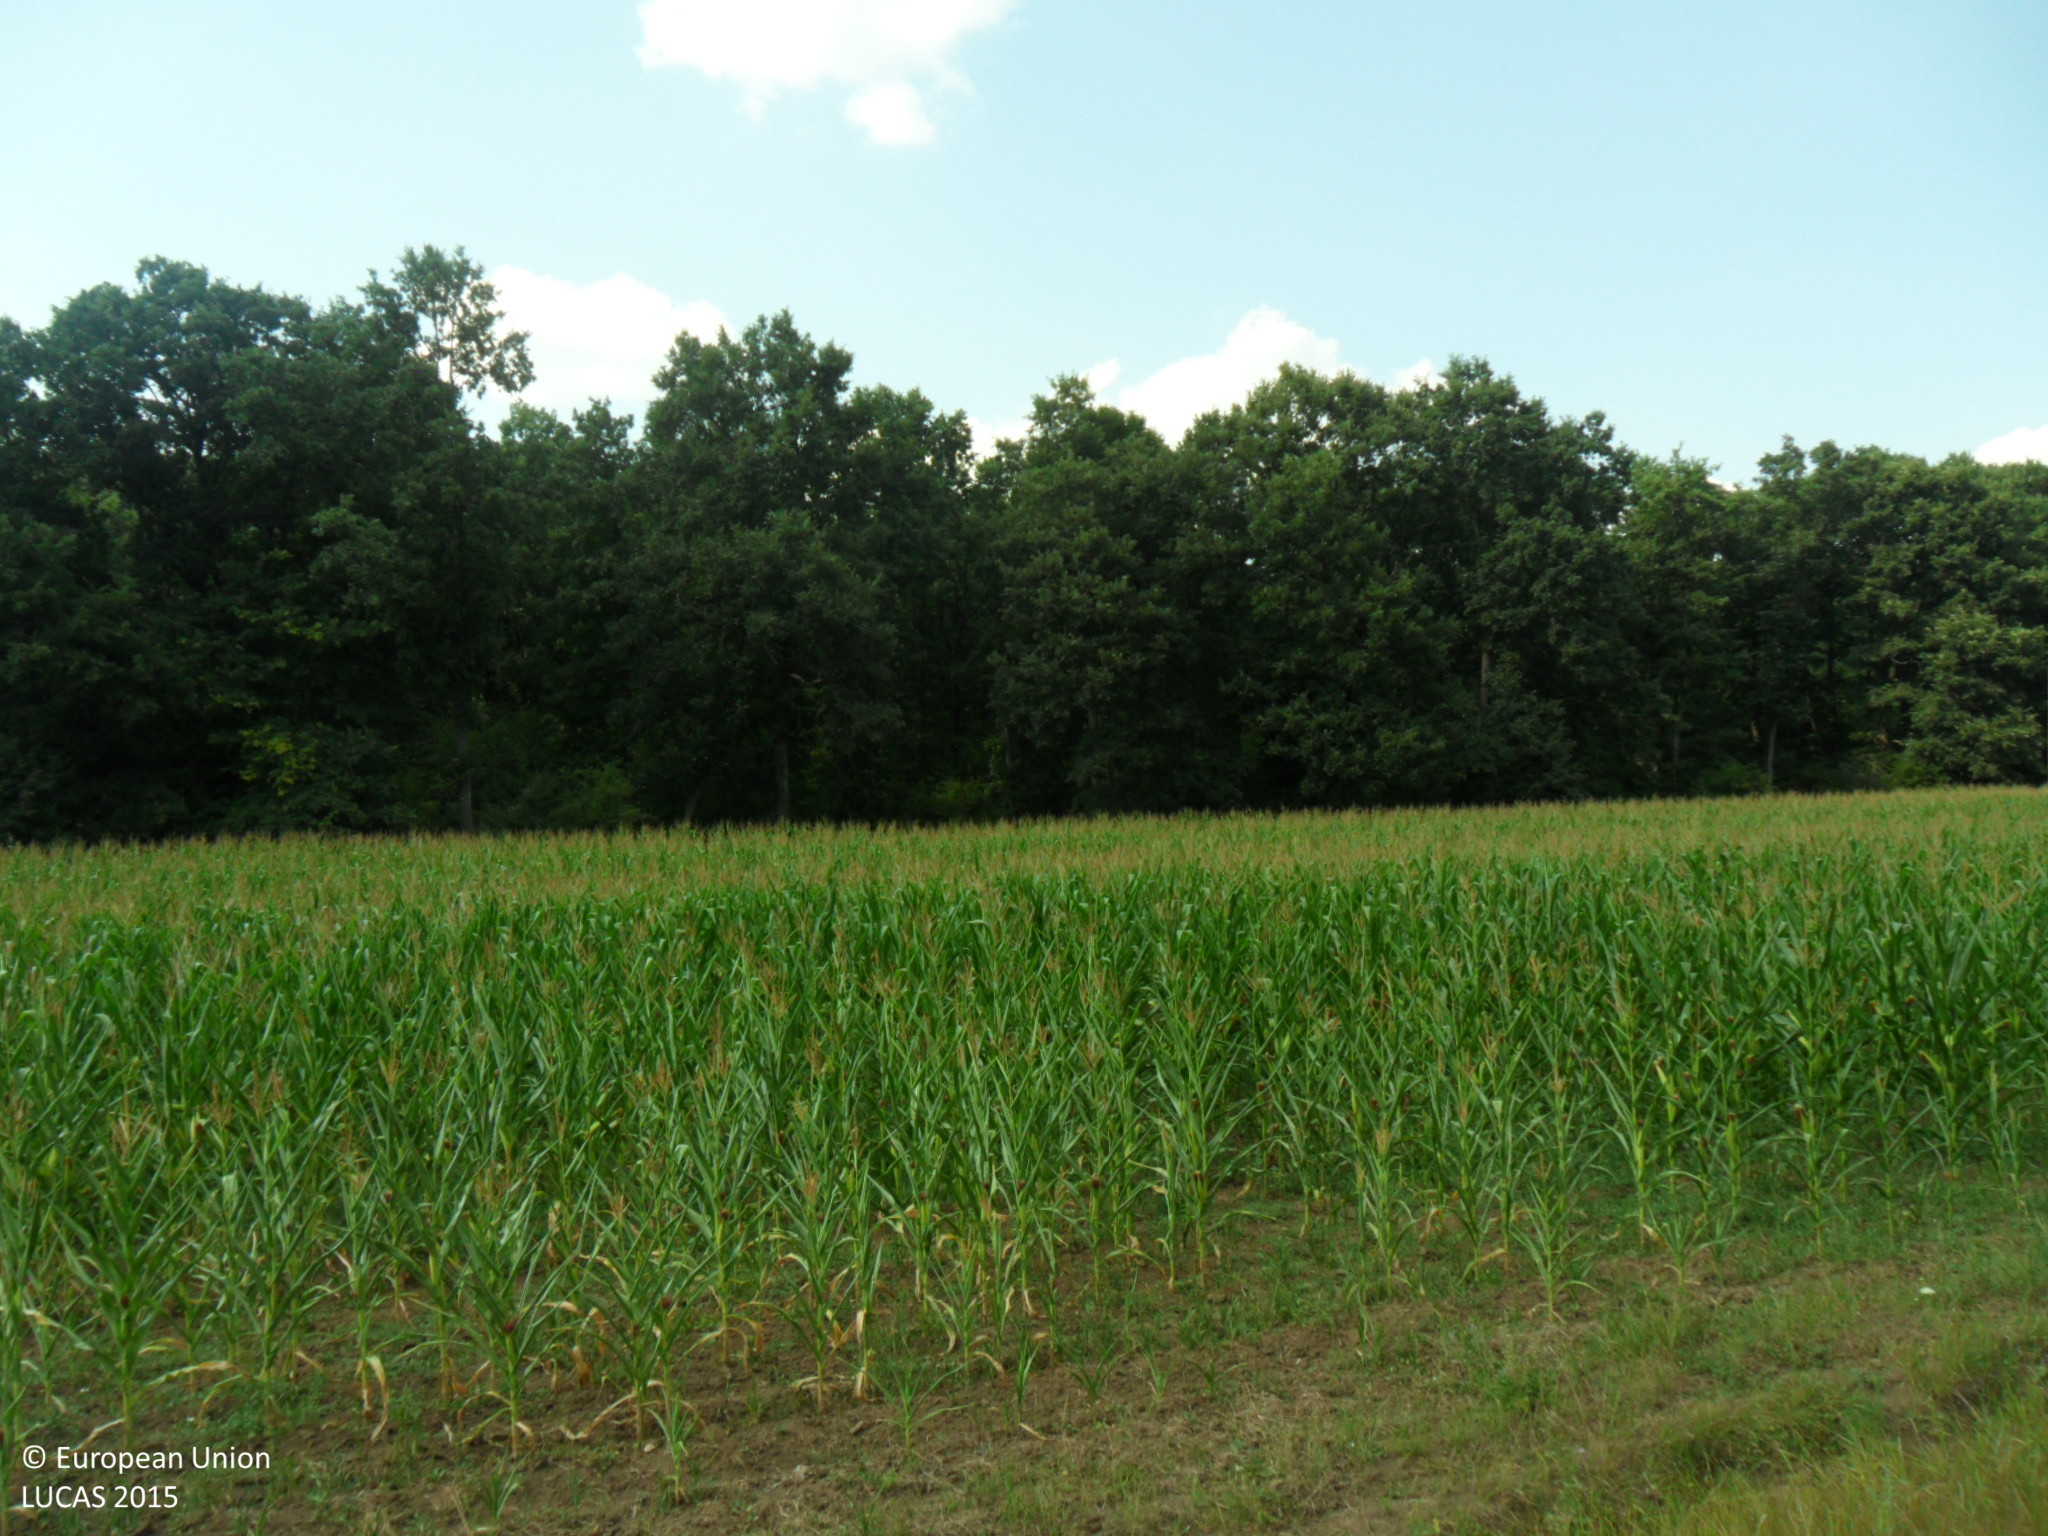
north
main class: Shrubland
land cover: Shrubland with sparse tree cover
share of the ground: > 75 %
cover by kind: shrubs 95 %, broadleaved forest trees 5 %
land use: Semi-natural and natural areas not in use
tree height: > 5 m
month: July
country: BG
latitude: 43.5821
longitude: 27.2017
